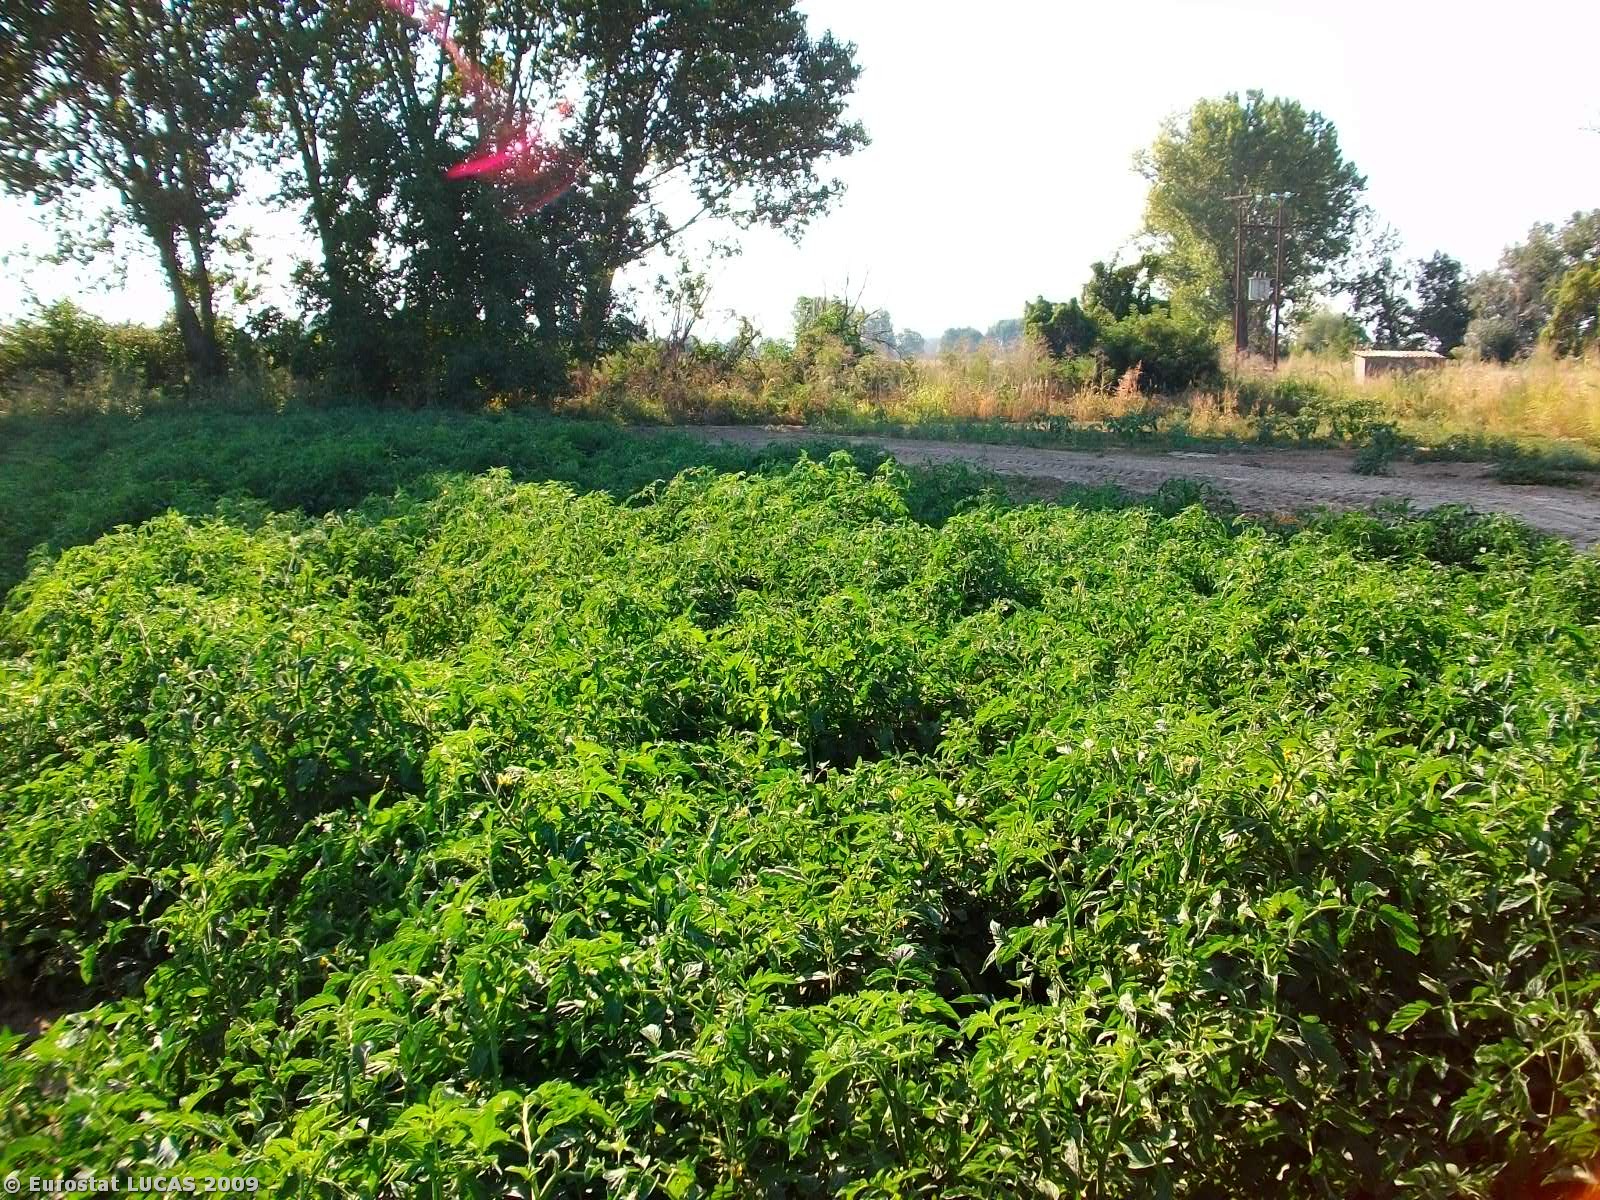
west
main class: Cropland
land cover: Tomatoes
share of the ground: > 75 %
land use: Agriculture (excluding fallow land and kitchen gardens)
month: September
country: GR
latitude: 41.6113
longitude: 26.5577
